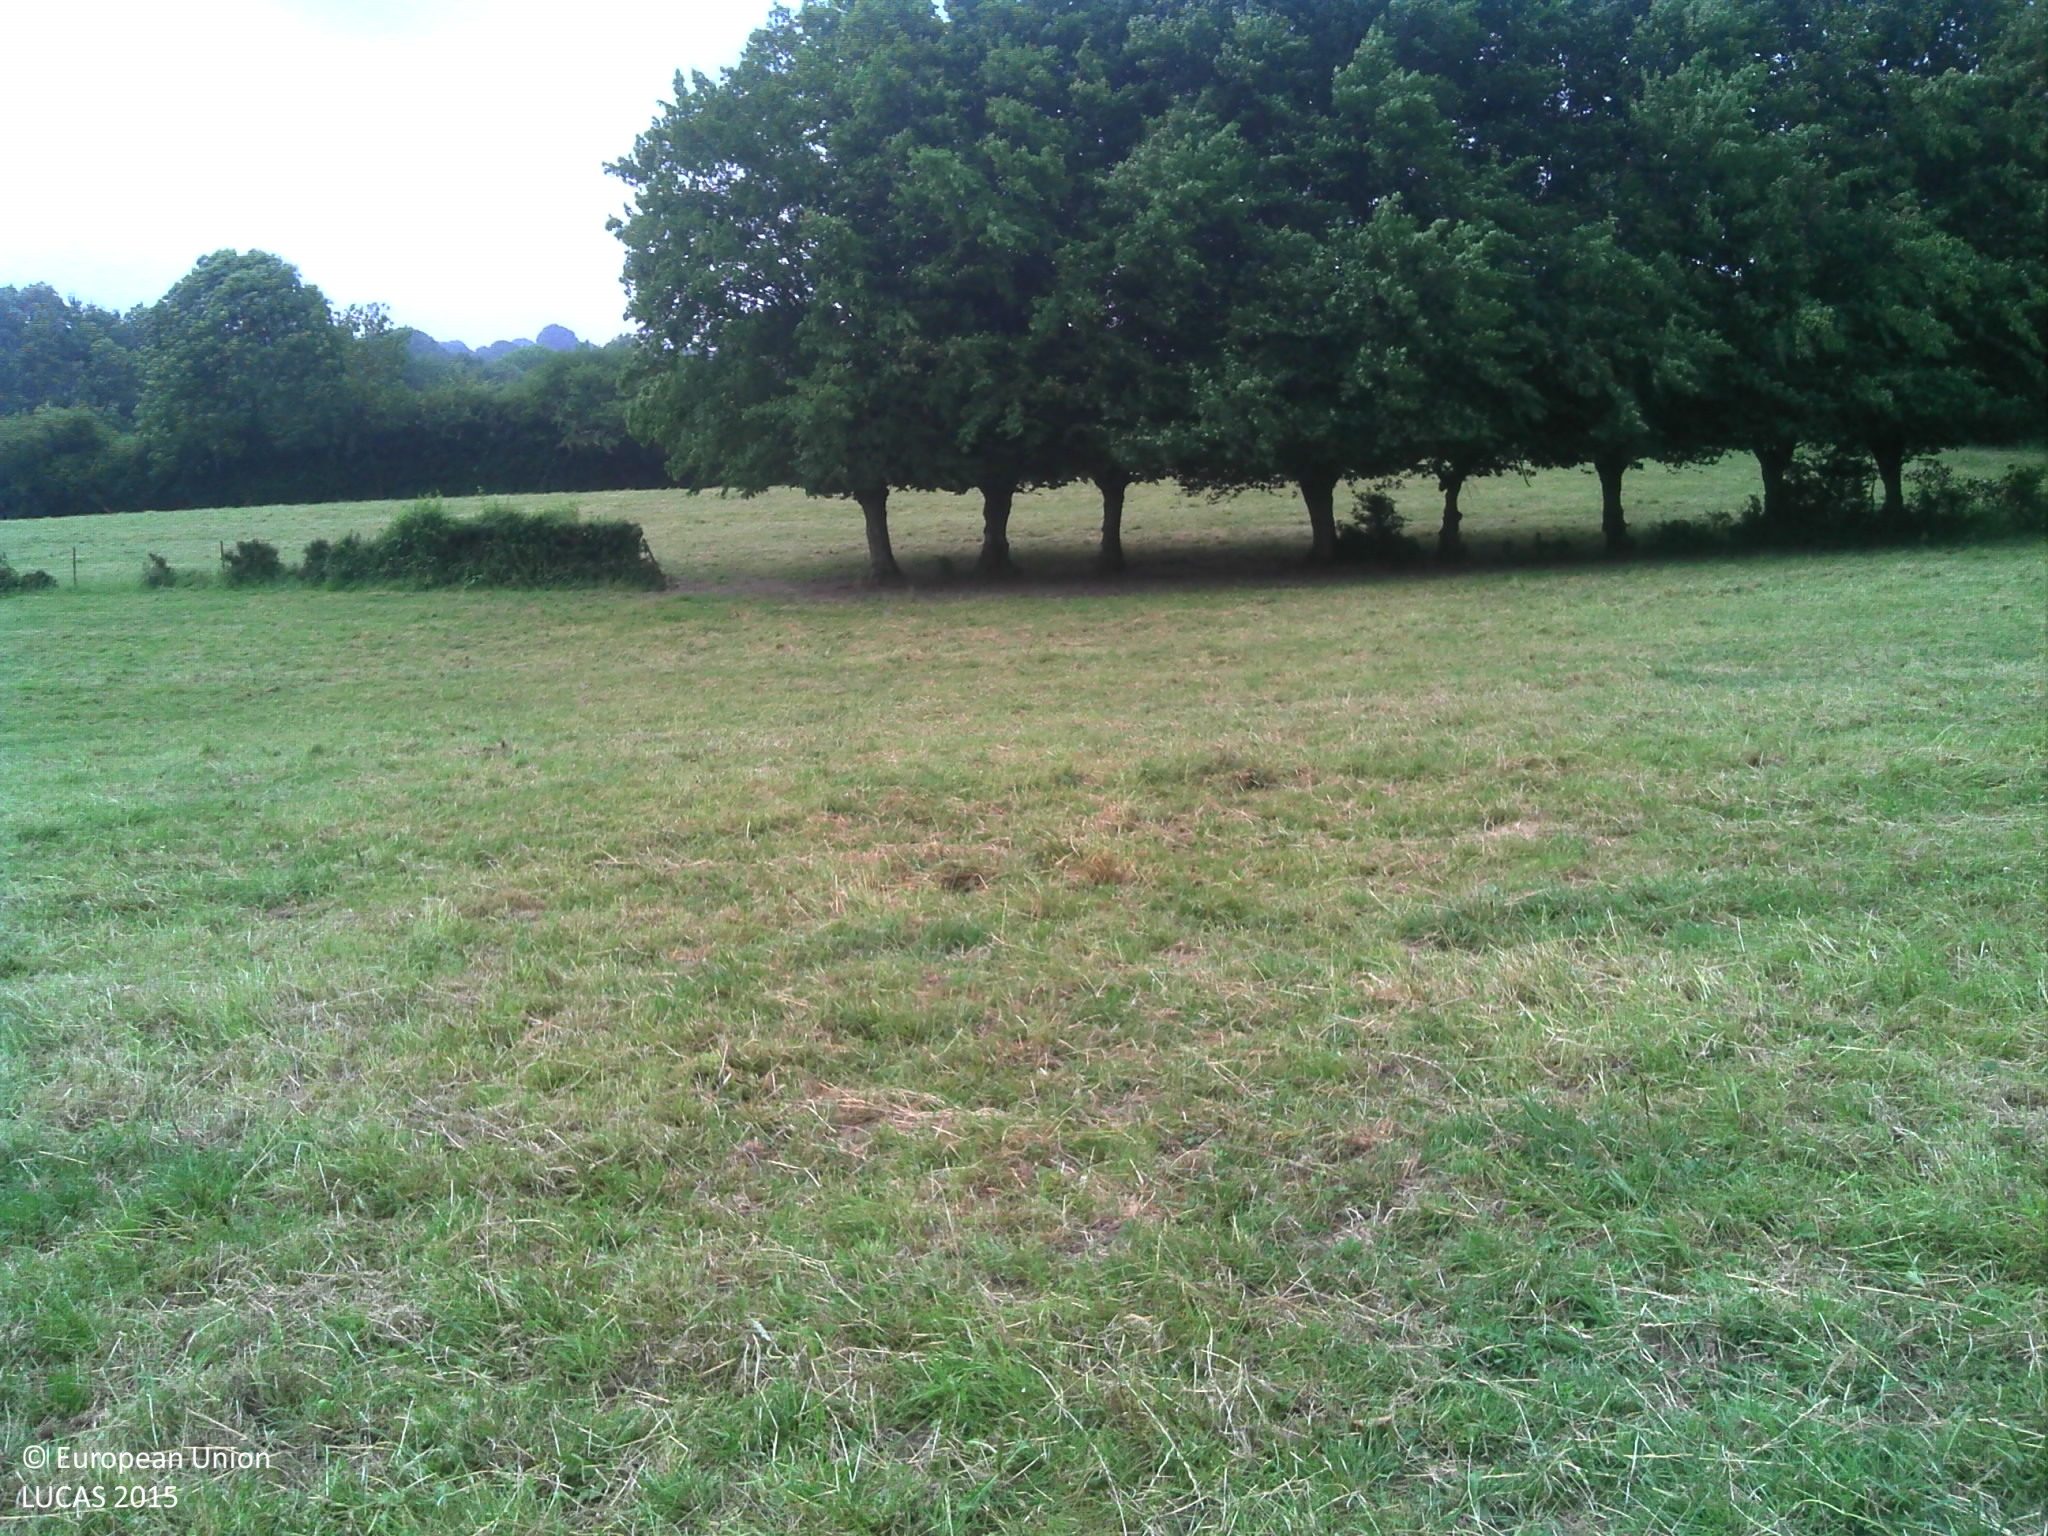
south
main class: Grassland
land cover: Grassland without tree/shrub cover
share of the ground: > 75 %
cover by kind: herbaceous plants 100 %
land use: Agriculture (excluding fallow land and kitchen gardens)
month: June
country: FR
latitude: 50.0072
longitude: 3.9805
